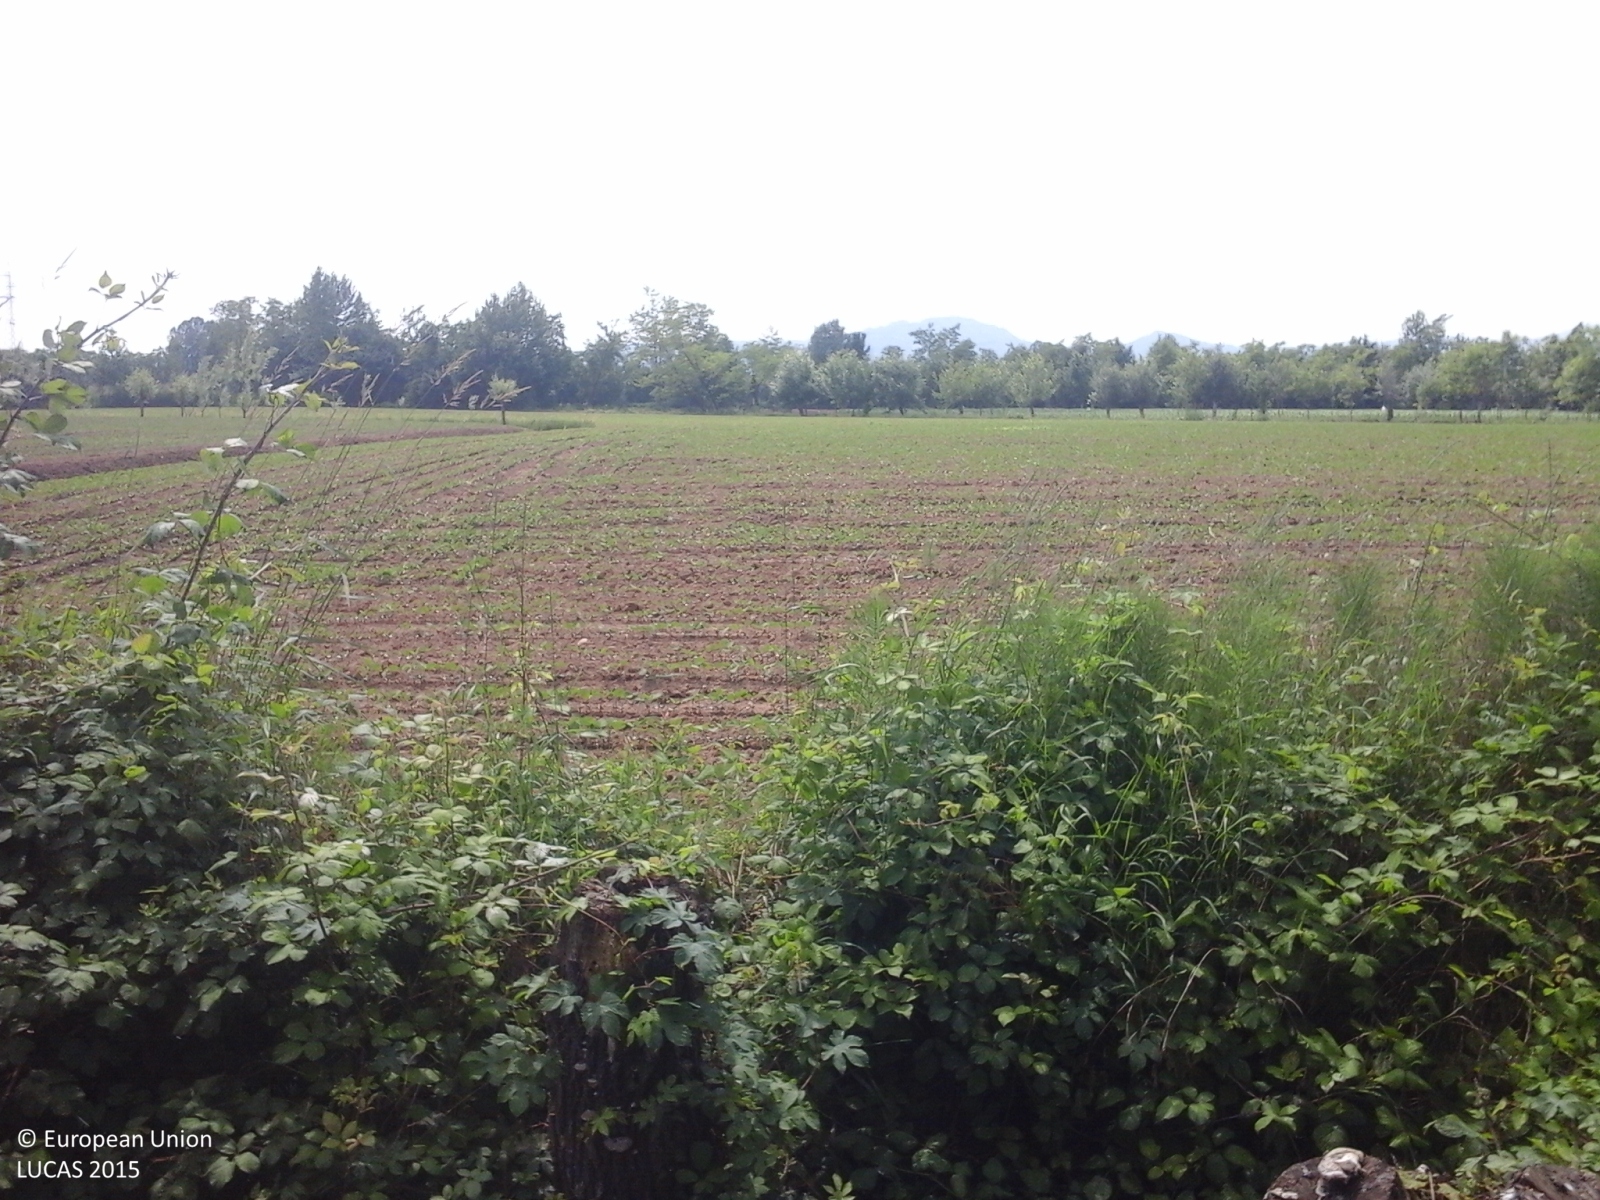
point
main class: Cropland
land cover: Soya
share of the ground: < 10 %
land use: Agriculture (excluding fallow land and kitchen gardens)
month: May
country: IT
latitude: 45.6196
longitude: 11.5237
